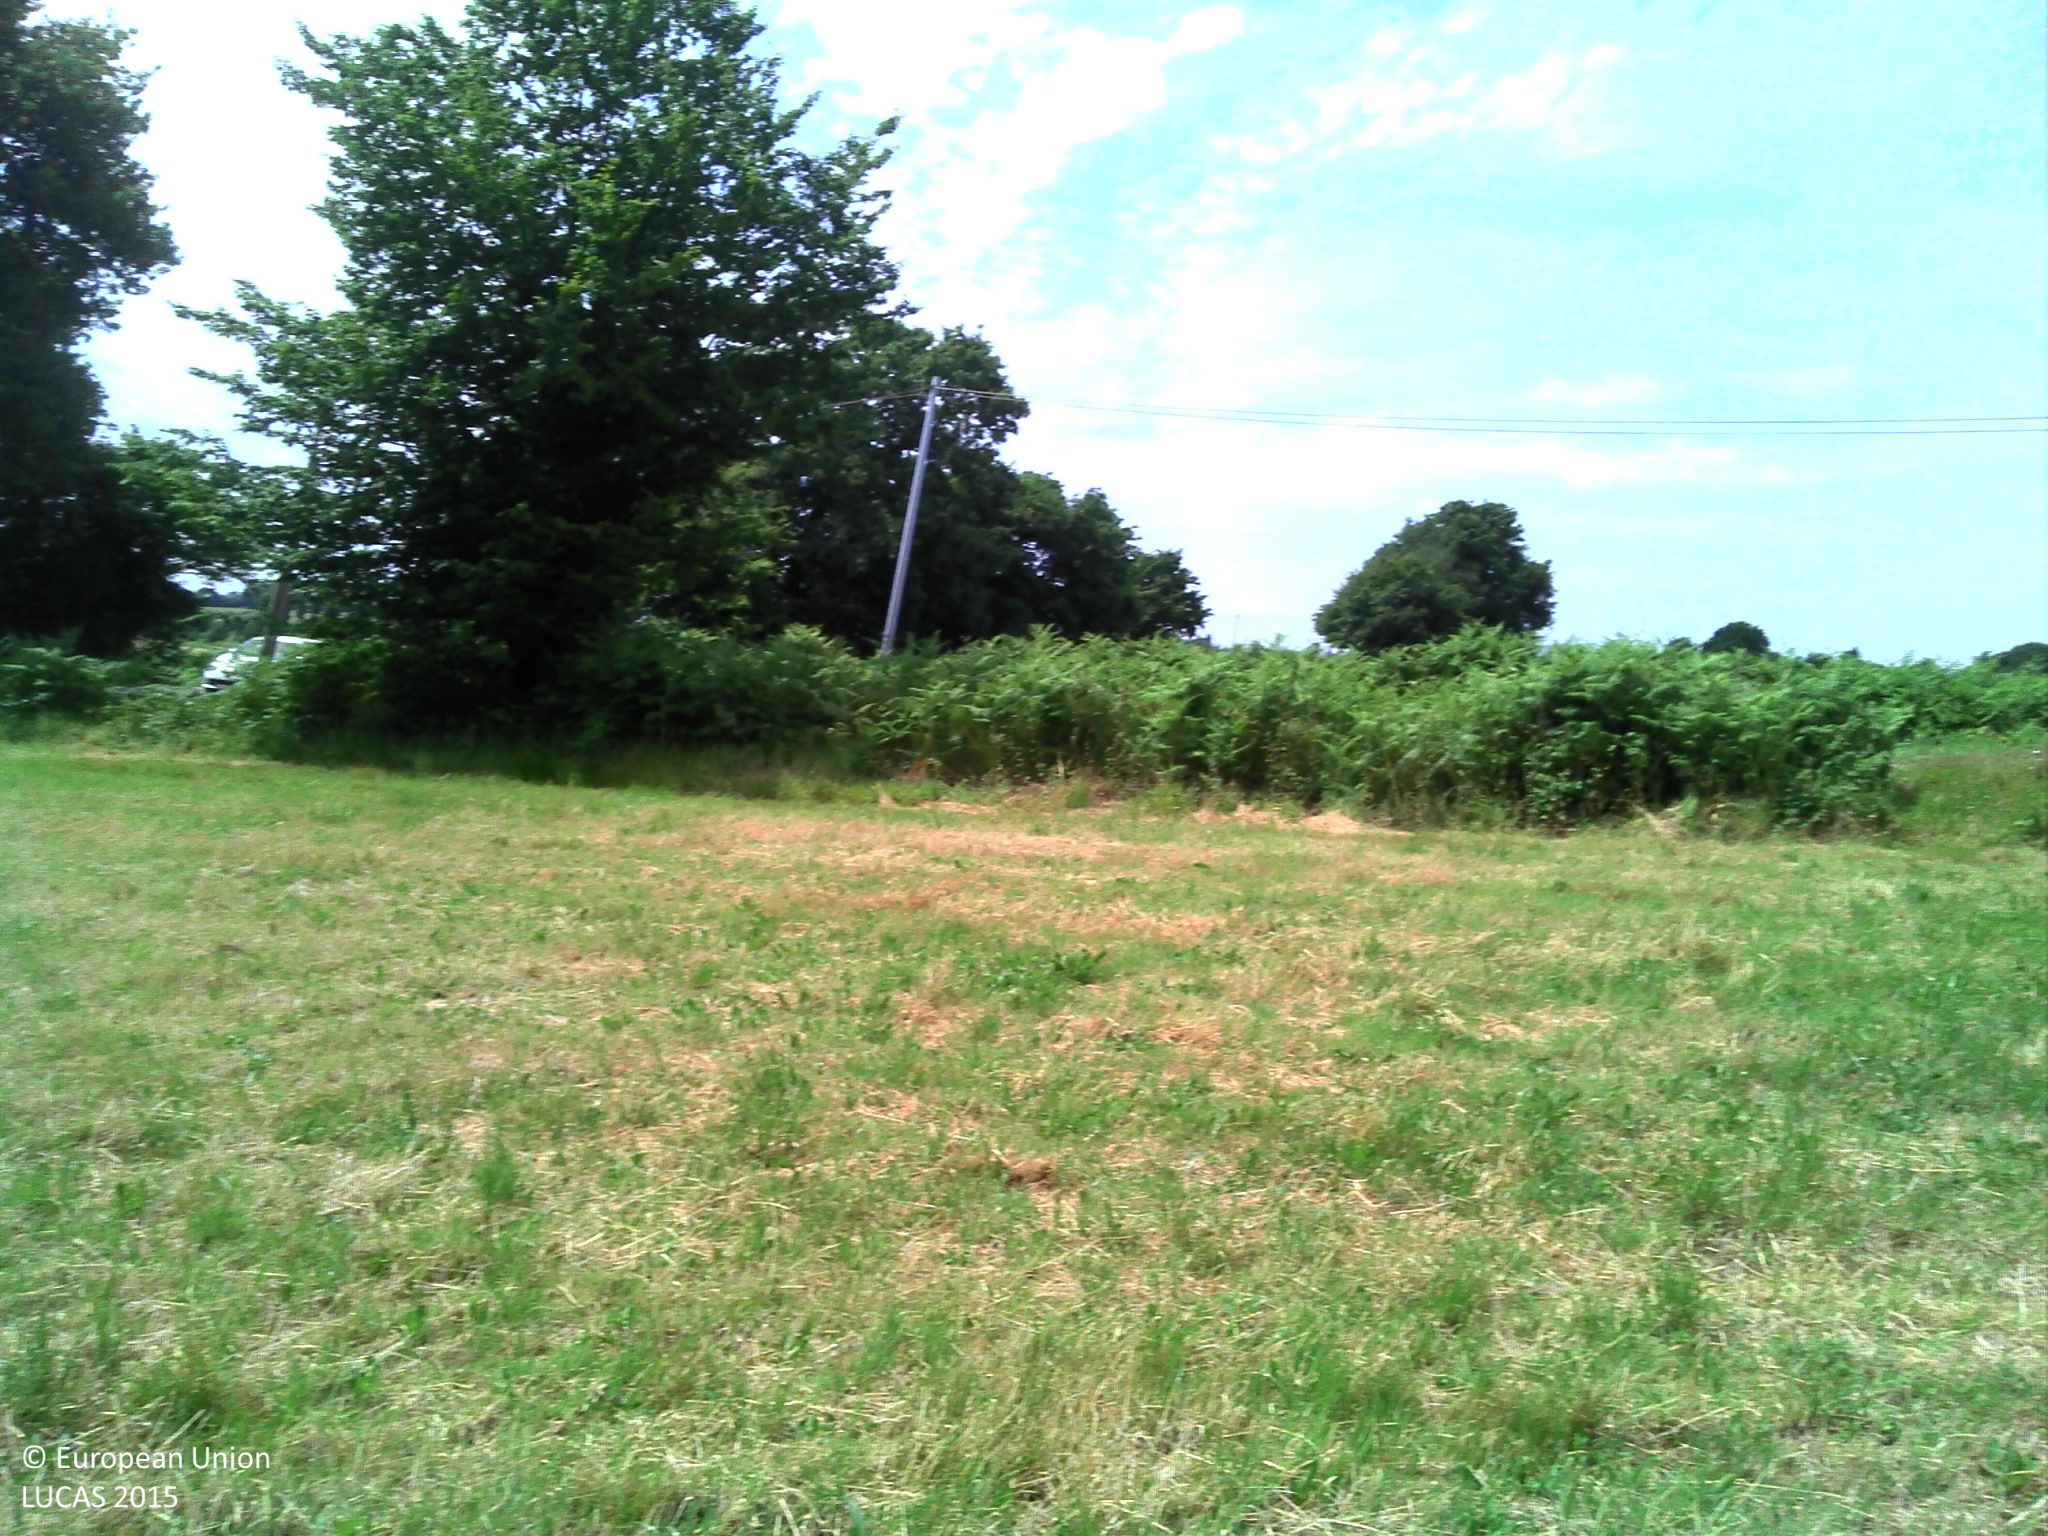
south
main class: Grassland
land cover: Grassland without tree/shrub cover
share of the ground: > 75 %
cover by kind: herbaceous plants 100 %
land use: Agriculture (excluding fallow land and kitchen gardens)
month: June
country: FR
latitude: 47.9229
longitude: -2.0568
